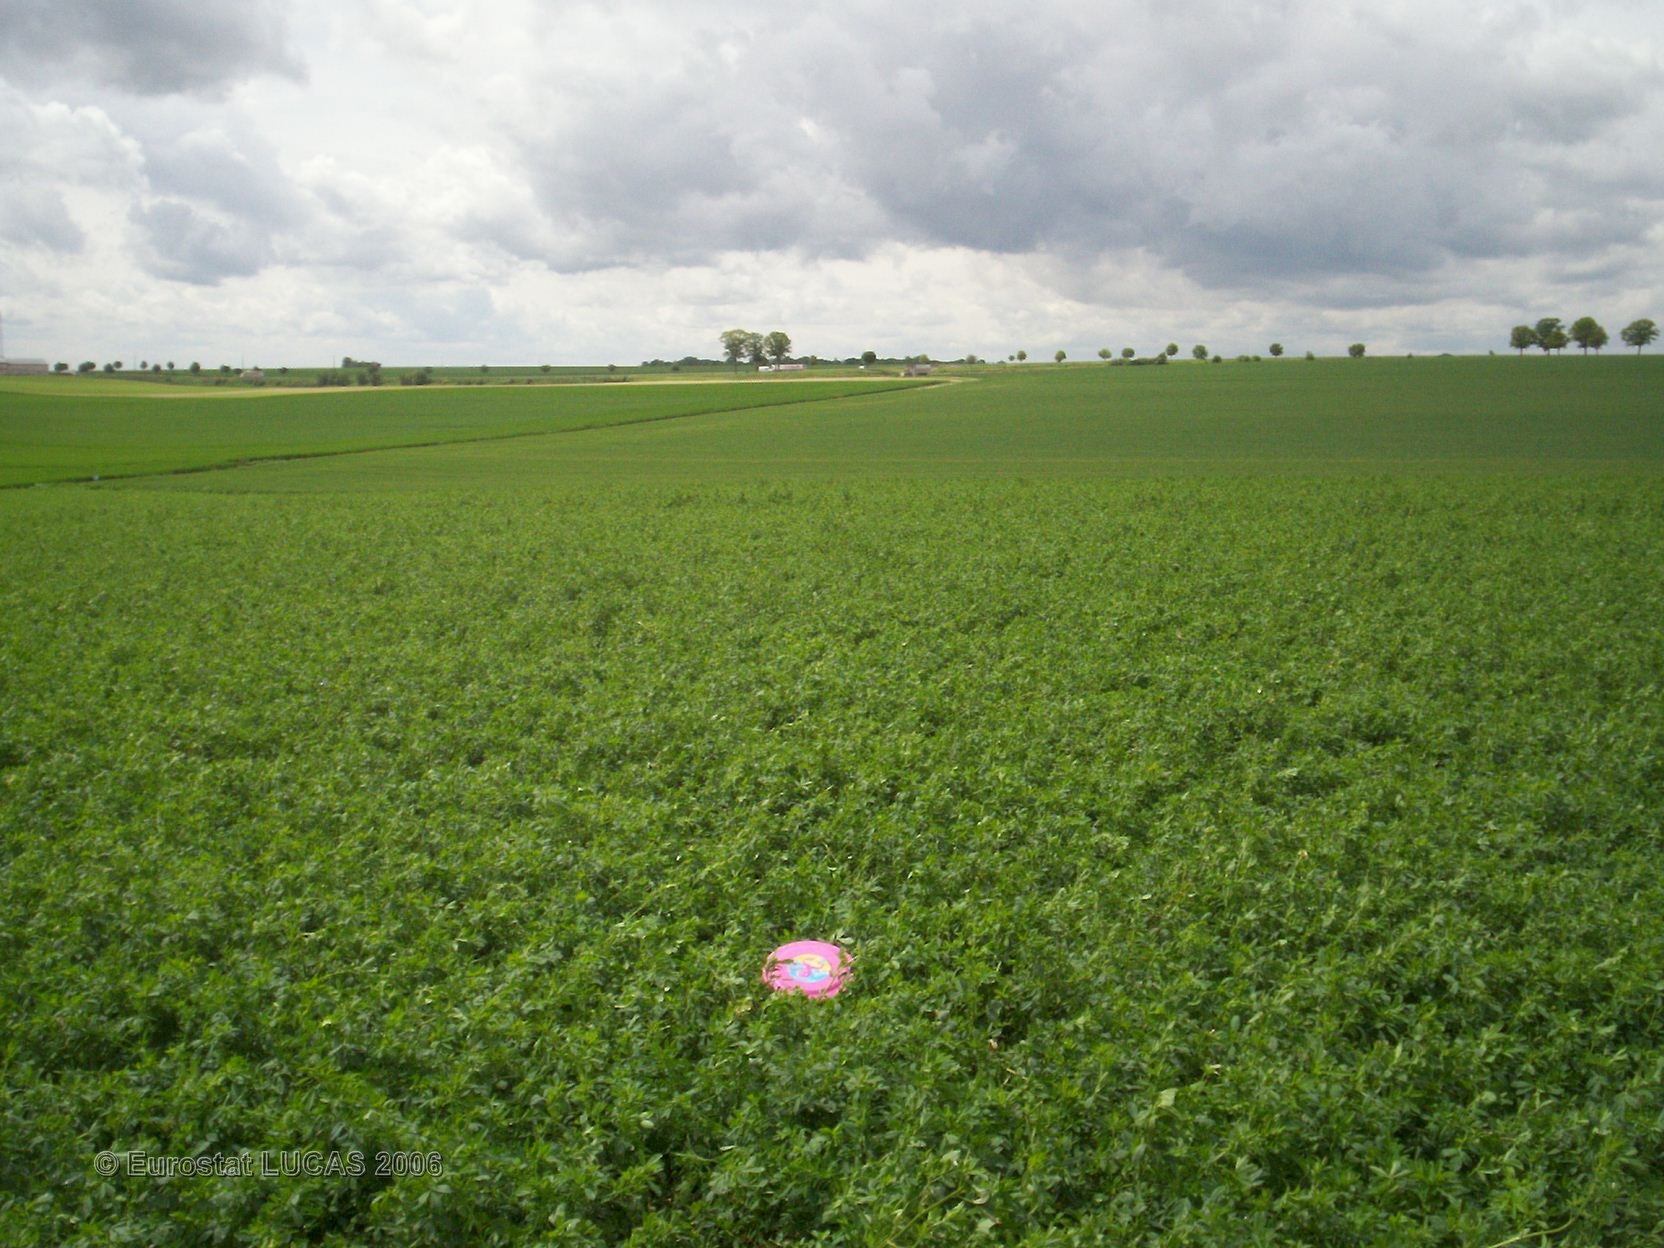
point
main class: Cropland
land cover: Lucerne
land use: Agriculture (excluding fallow land and kitchen gardens)
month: May
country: FR
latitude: 49.4660
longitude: 4.3246
